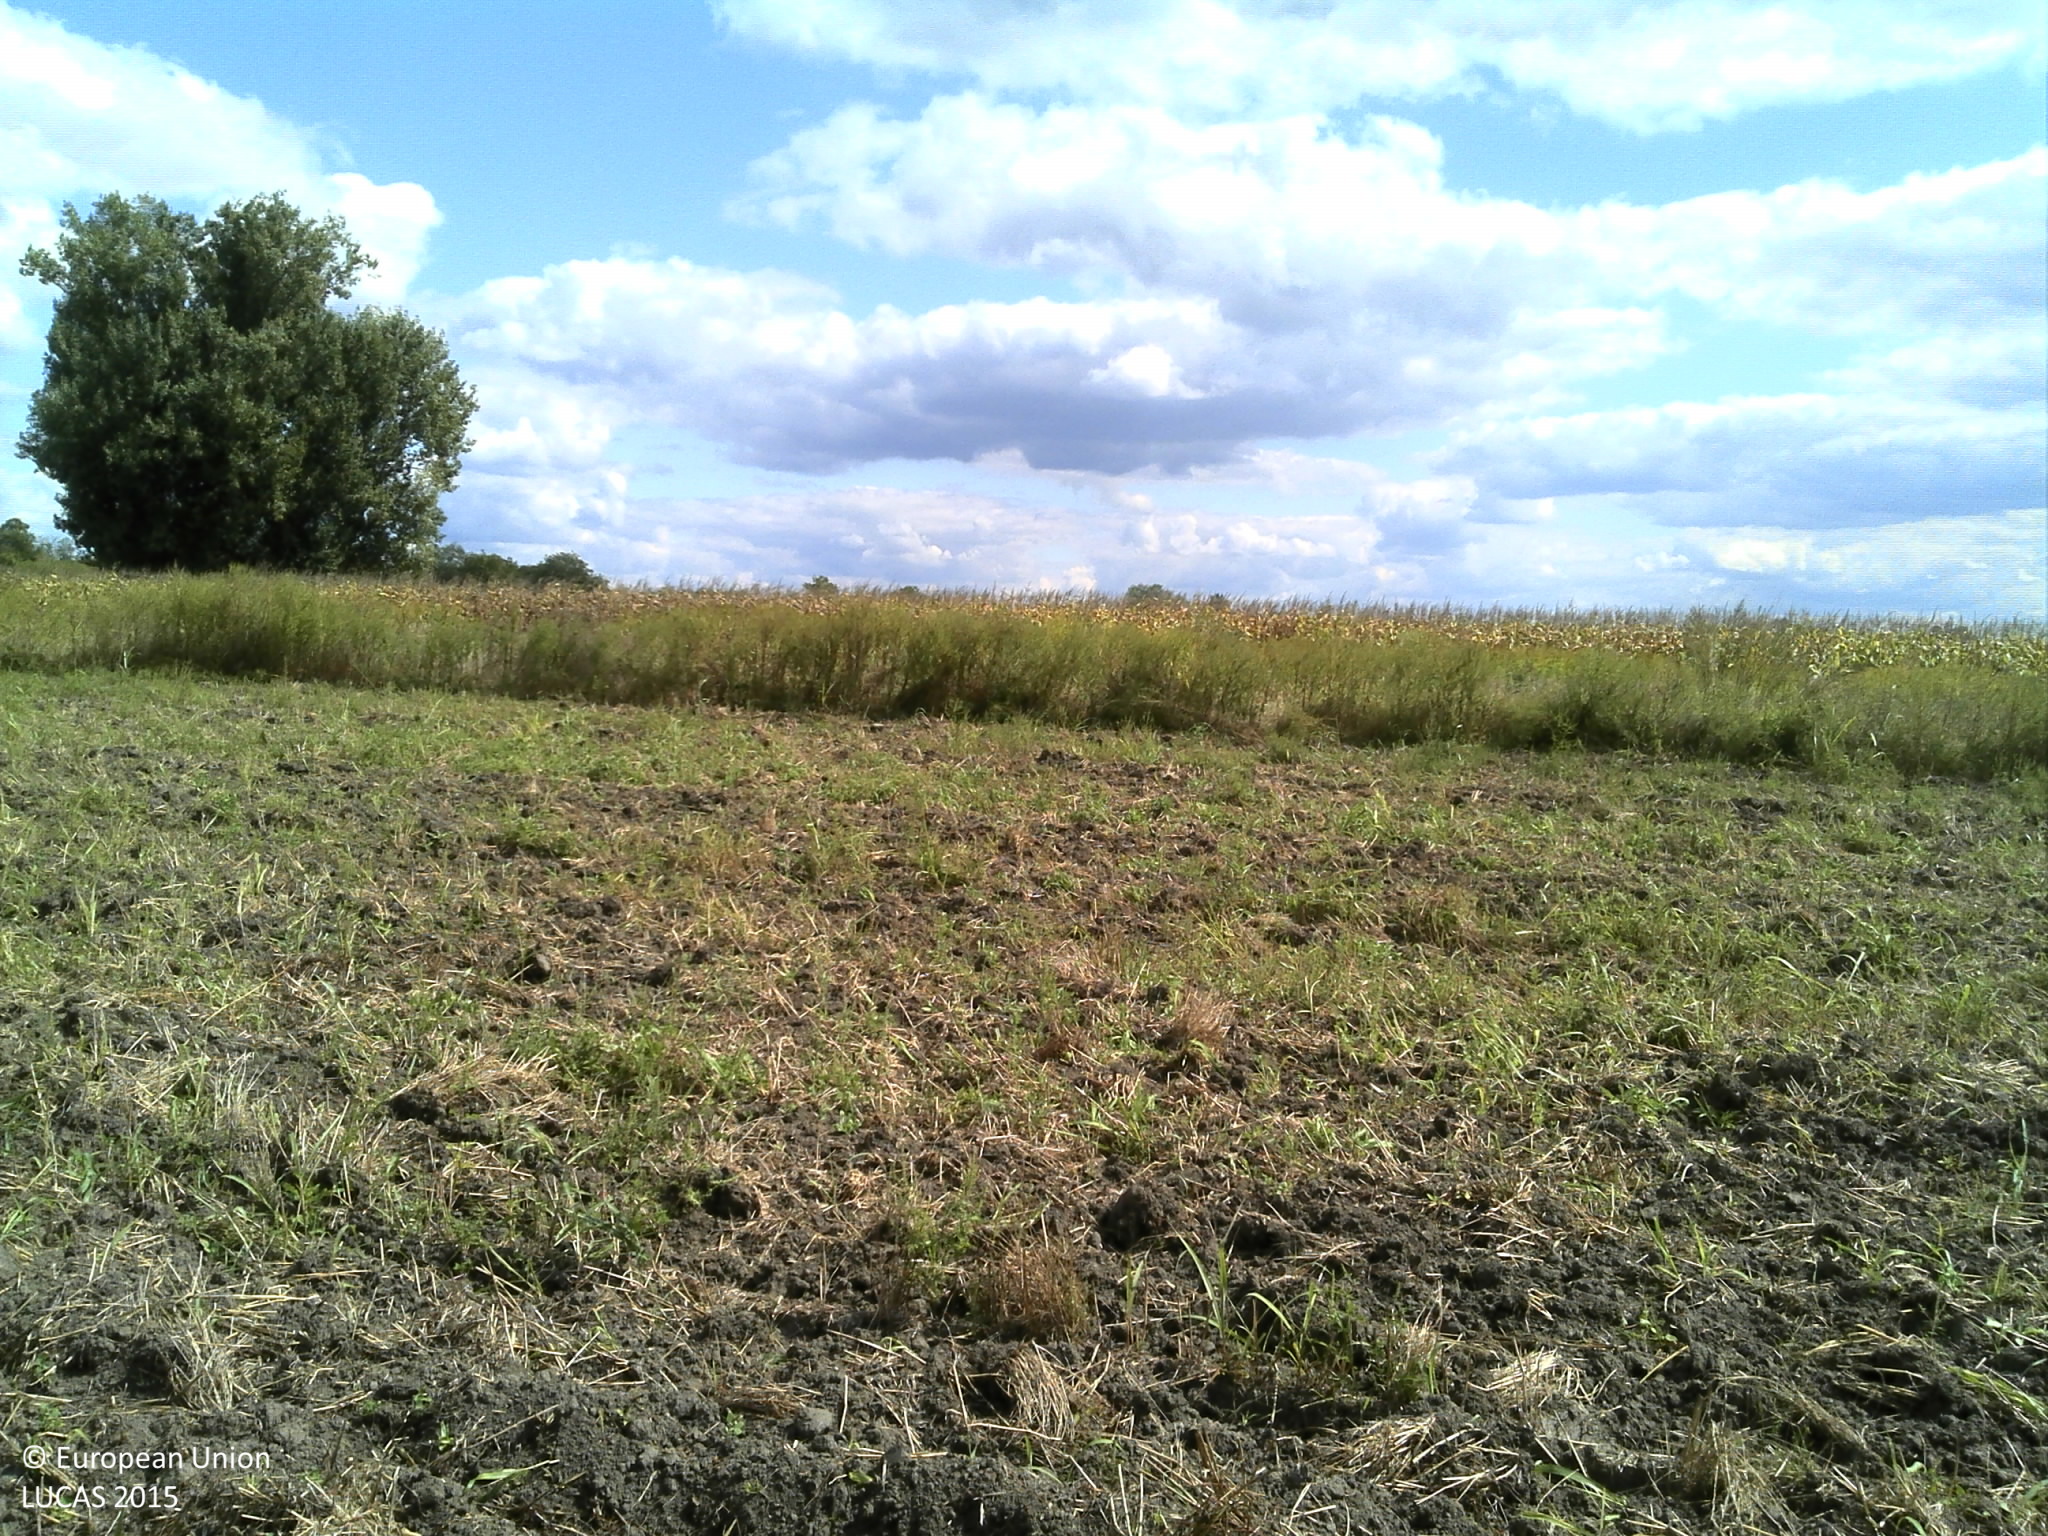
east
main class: Cropland
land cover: Barley
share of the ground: > 75 %
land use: Agriculture (excluding fallow land and kitchen gardens)
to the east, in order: Barley; Spontaneously vegetated surfaces; Maize; Clovers; Grass margins; Ditches and canals; Grass margins; Other bare soil
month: September
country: HR
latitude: 45.6965
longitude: 18.5993
